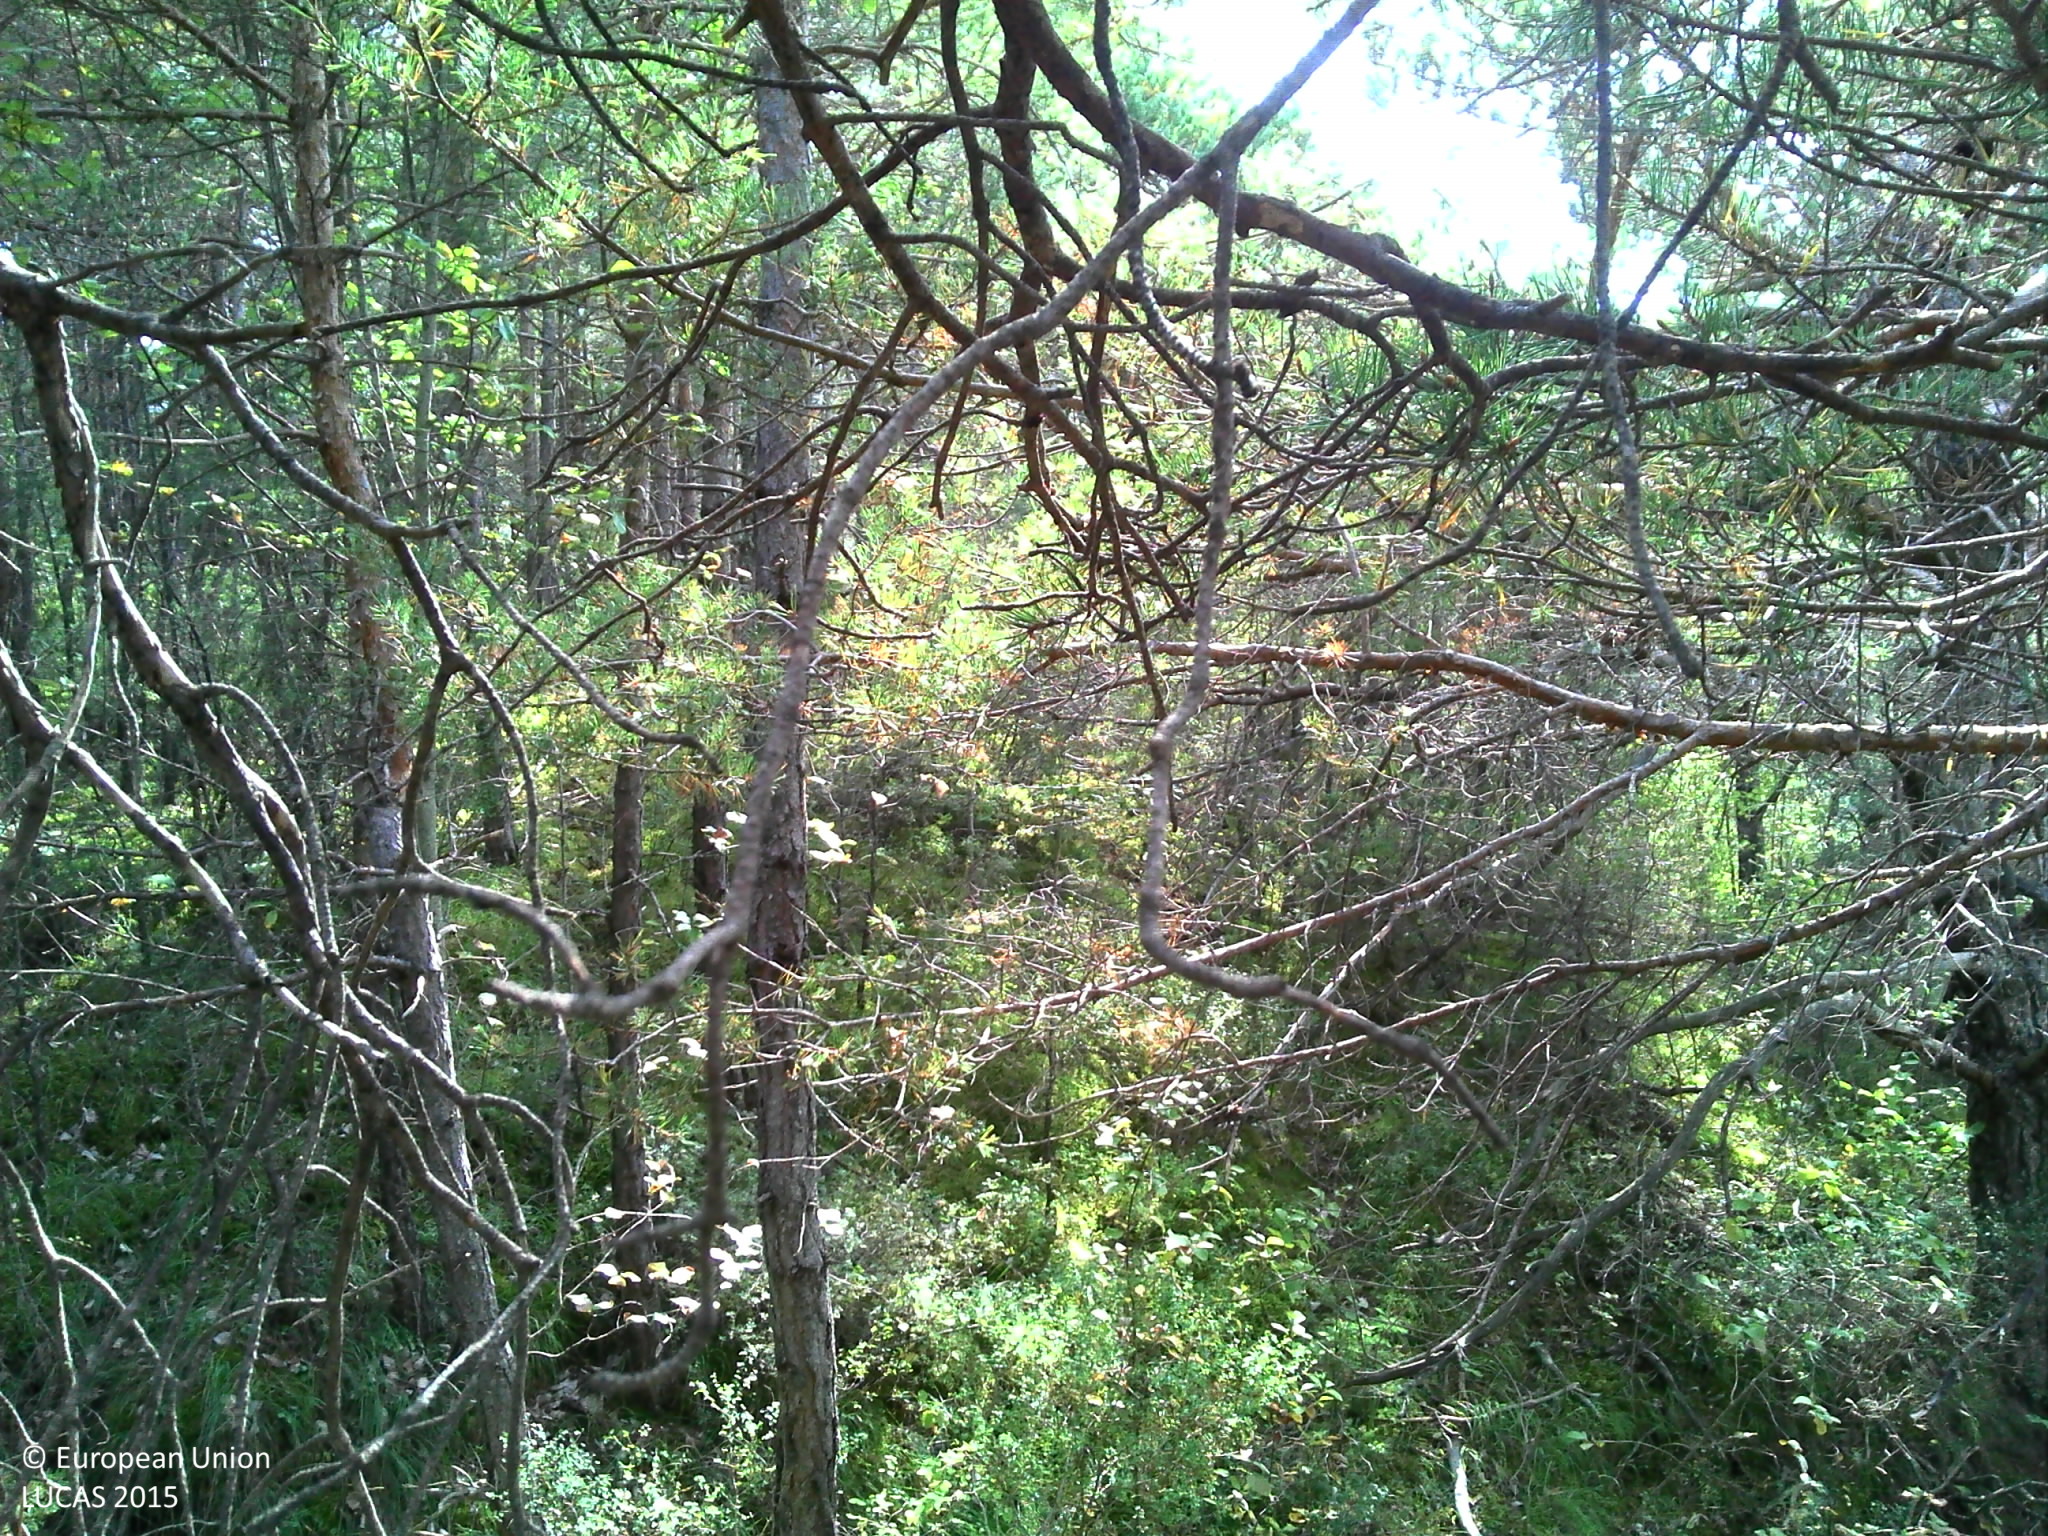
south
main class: Woodland
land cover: Pine dominated coniferous woodland
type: hemiboreal forest and nemoral coniferous forest and mixed broadleaved-coniferous forest
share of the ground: > 75 %
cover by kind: coniferous forest trees 70 %, broadleaved forest trees 10 %, shrubs 10 %, herbaceous plants 5 %, consolidated bare surface 5 %
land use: Forestry
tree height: > 5 m
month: September
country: FR
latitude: 44.5344
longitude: 6.2187
